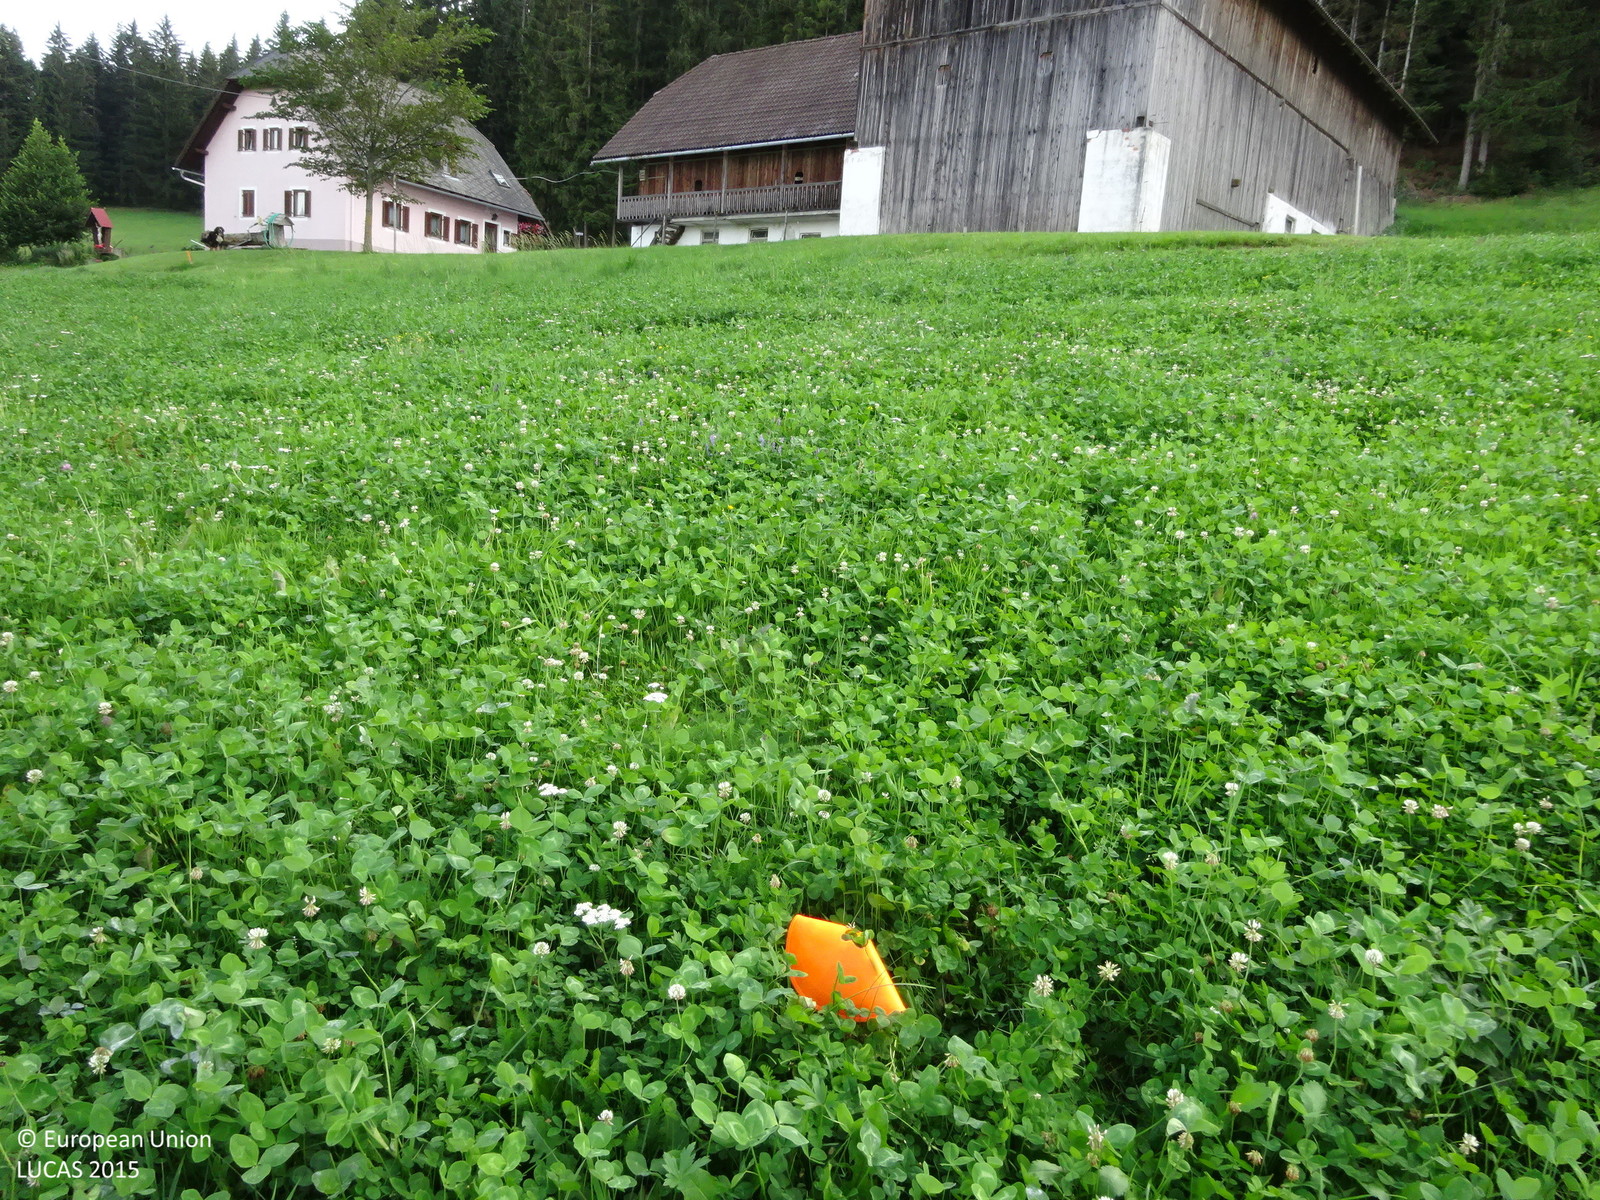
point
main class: Cropland
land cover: Clovers
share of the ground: > 75 %
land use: Agriculture (excluding fallow land and kitchen gardens)
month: August
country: AT
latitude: 47.4230
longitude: 15.7677
